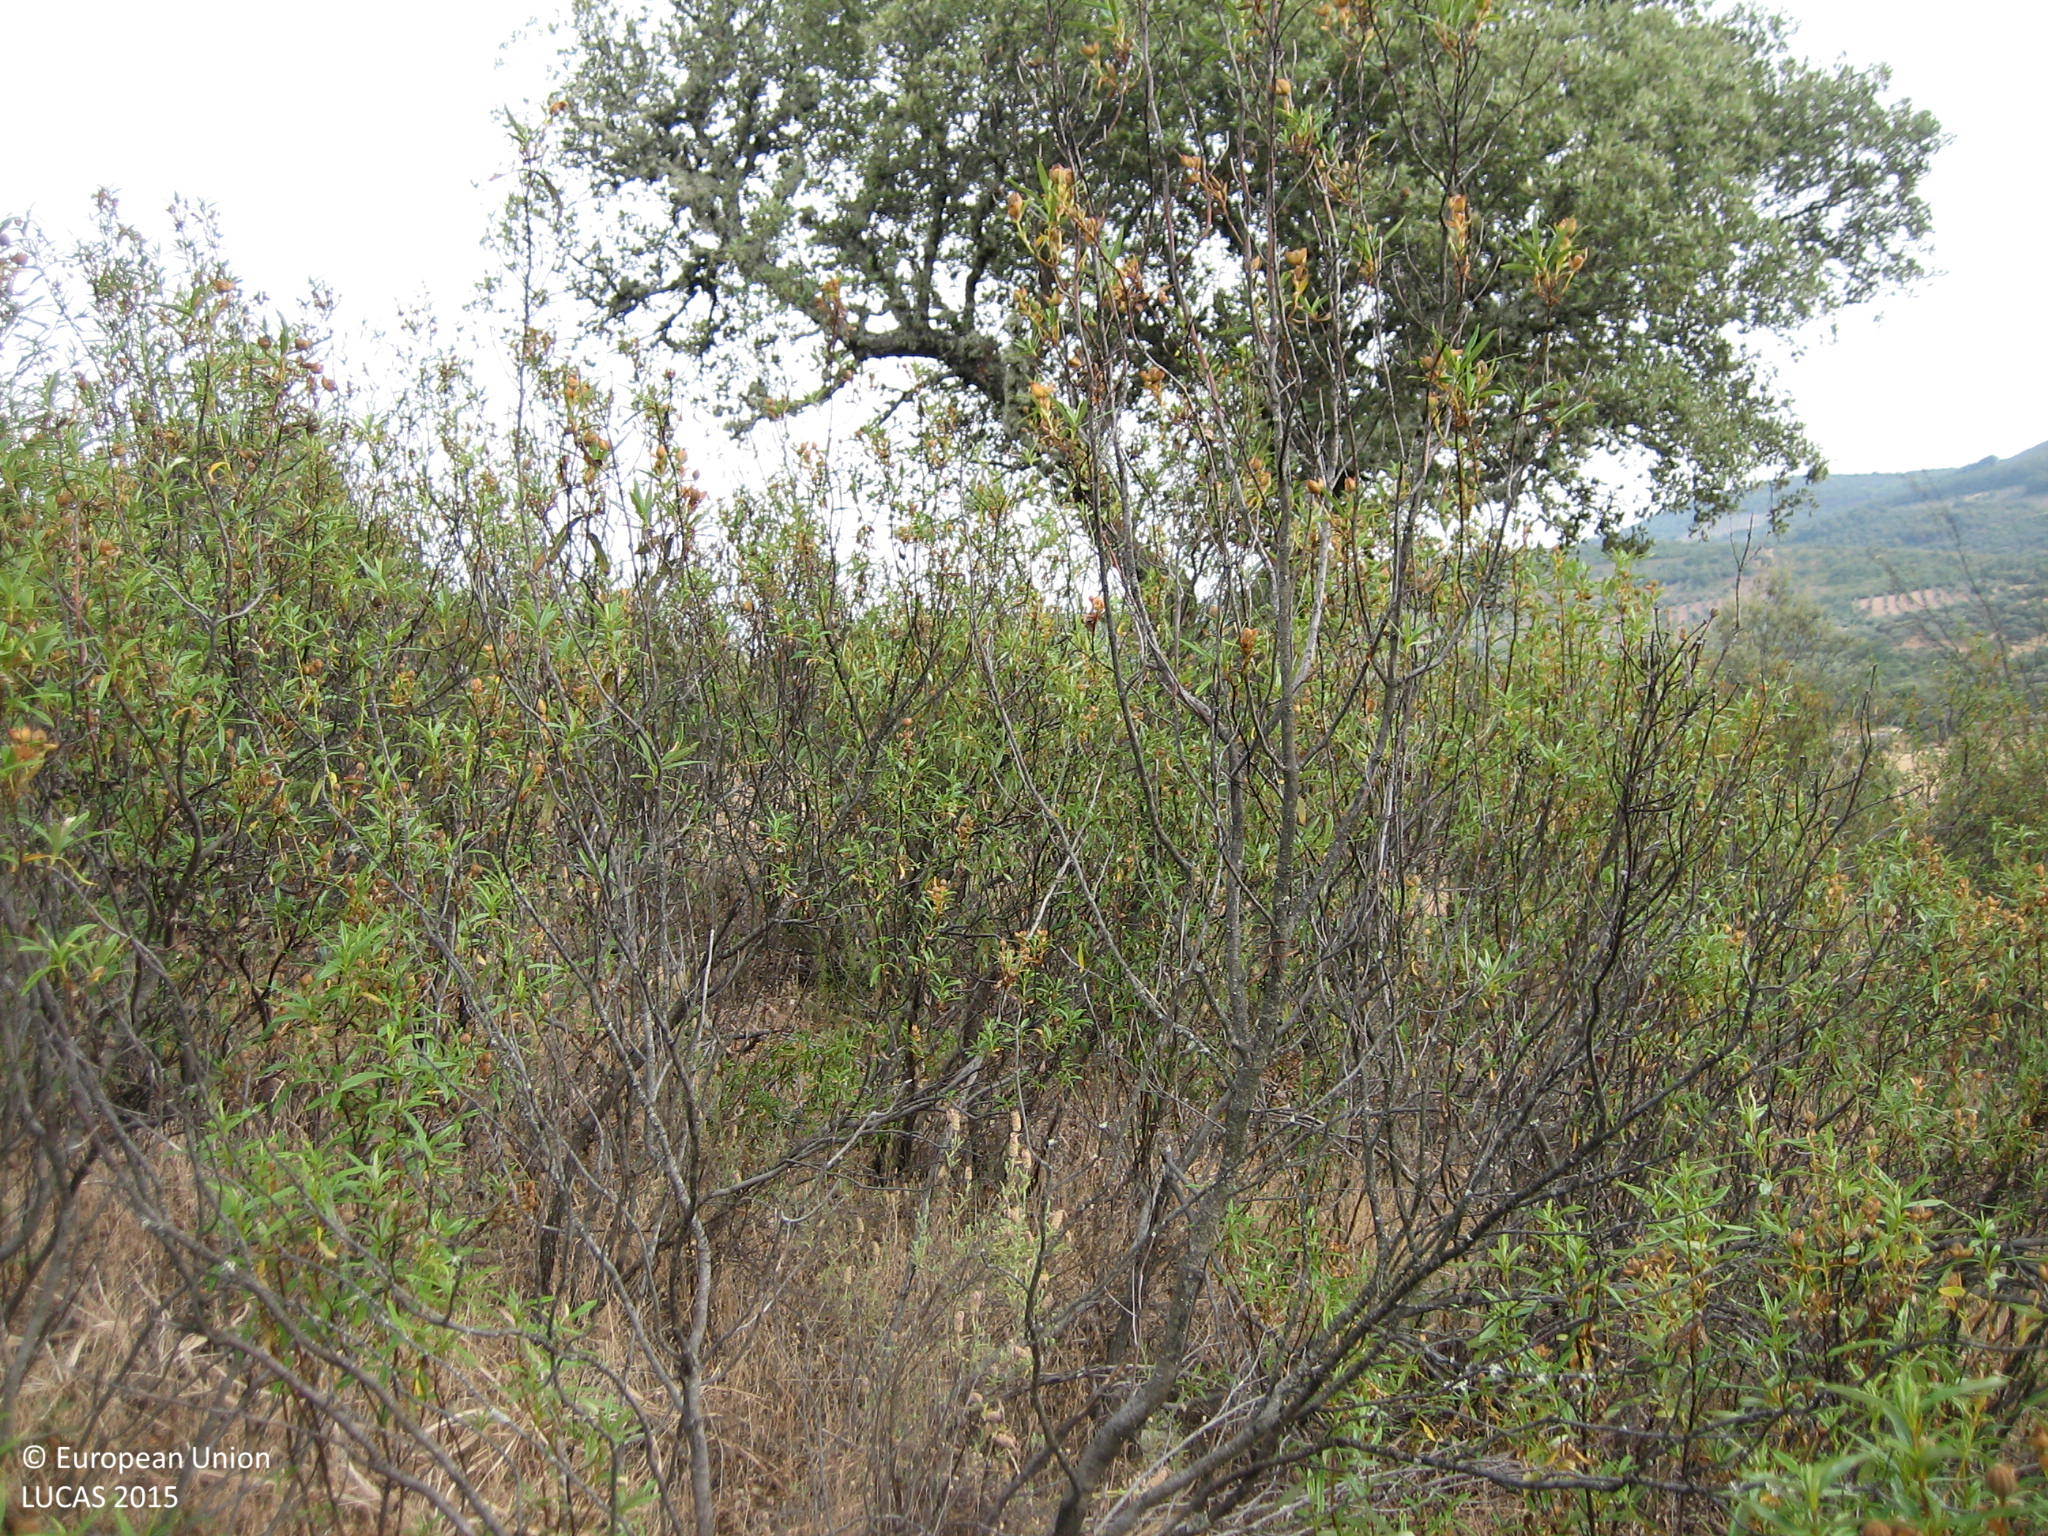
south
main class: Shrubland
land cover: Shrubland with sparse tree cover
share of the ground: > 75 %
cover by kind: shrubs 95 %, broadleaved forest trees 5 %
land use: Semi-natural and natural areas not in use
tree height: < 5 m
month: June
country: ES
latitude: 39.3211
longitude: -4.9214
